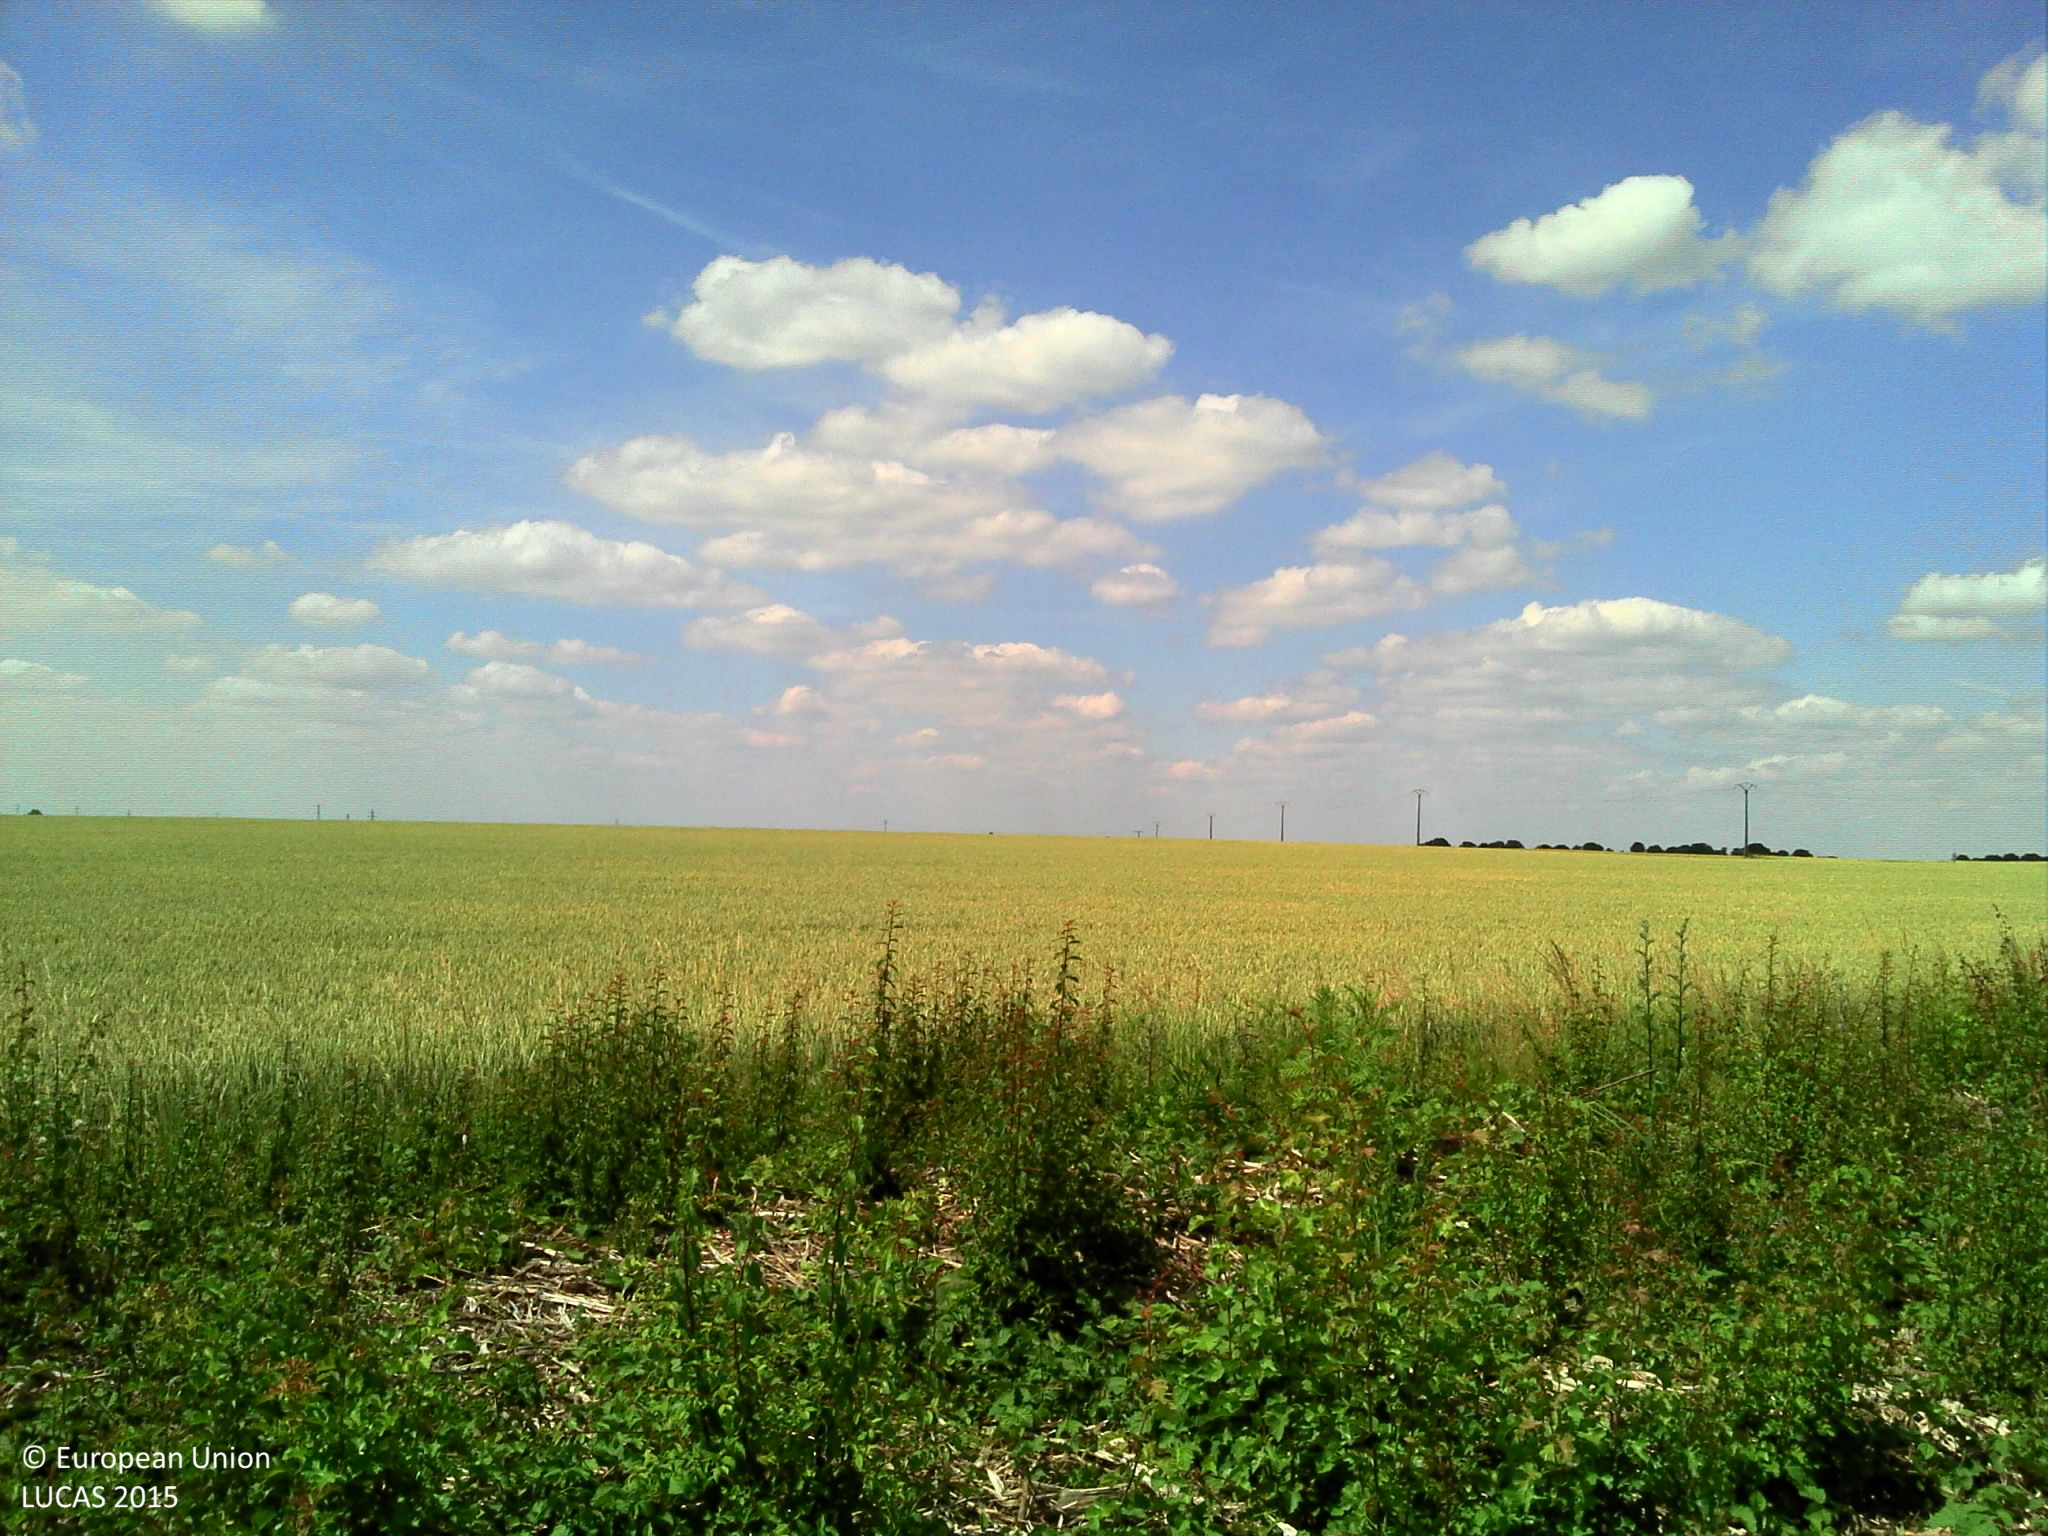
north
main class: Grassland
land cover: Spontaneously vegetated surfaces
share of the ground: > 75 %
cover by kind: herbaceous plants 85 %, unconsolidated bare surface 10 %, shrubs 5 %
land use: Semi-natural and natural areas not in use
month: June
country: FR
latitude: 49.2203
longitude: 2.8645
